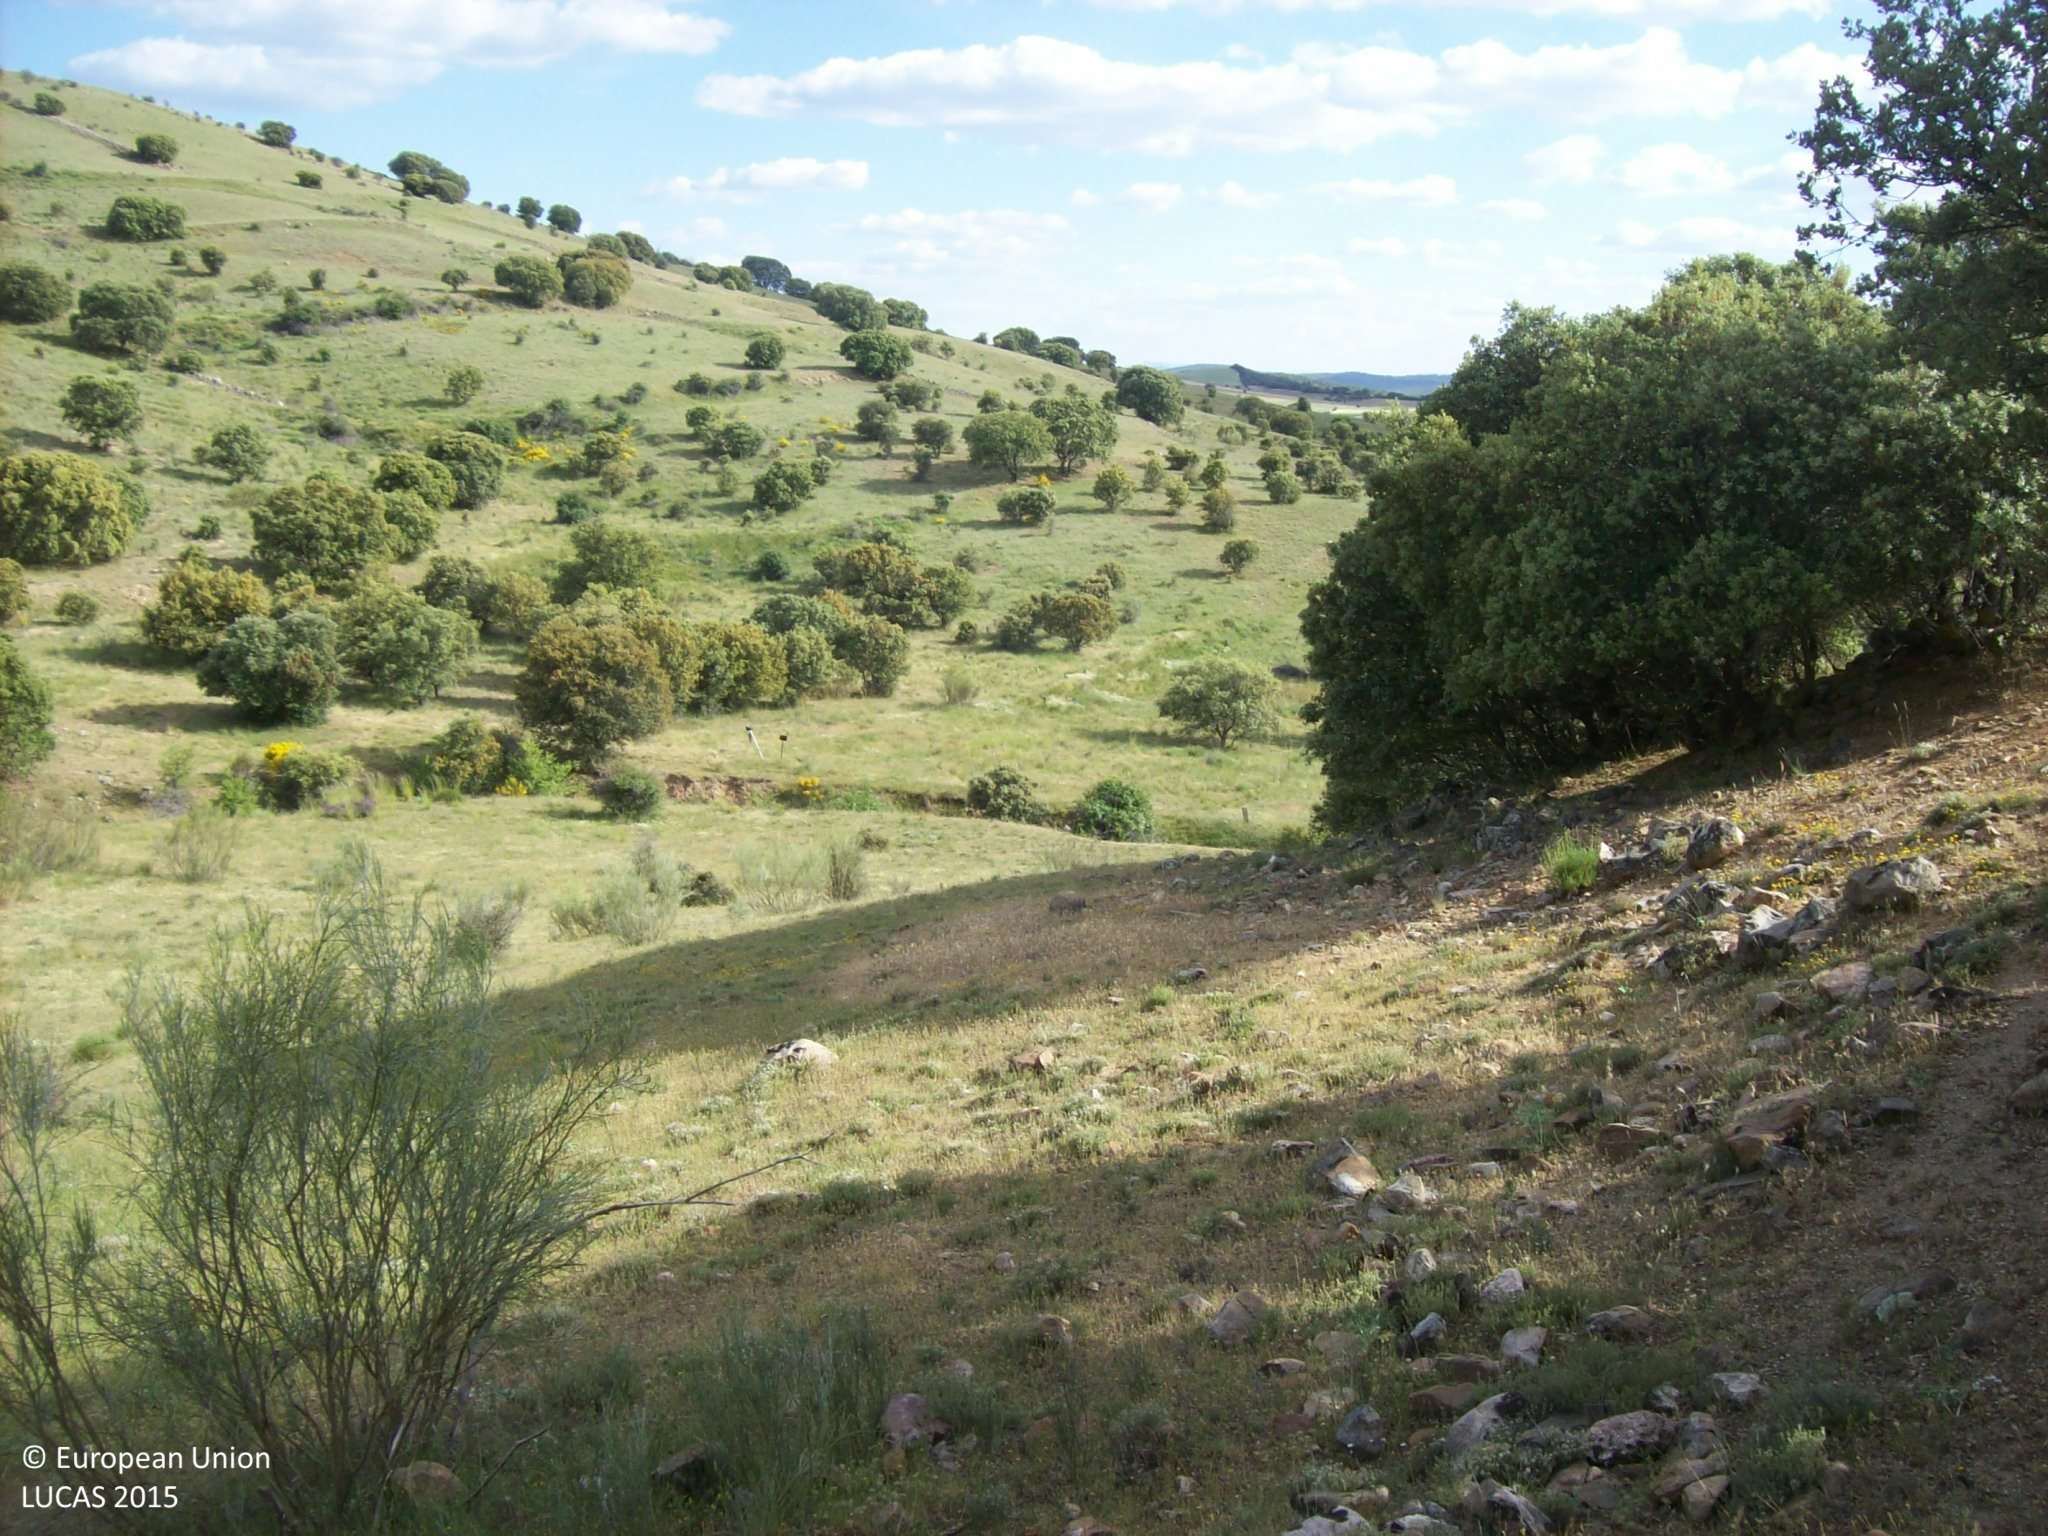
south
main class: Woodland
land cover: Broadleaved woodland
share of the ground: 10 - 25 %
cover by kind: herbaceous plants 55 %, shrubs 25 %, broadleaved forest trees 10 %, consolidated bare surface 10 %
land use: Semi-natural and natural areas not in use
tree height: < 5 m
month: May
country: ES
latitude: 40.8296
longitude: -4.5338
